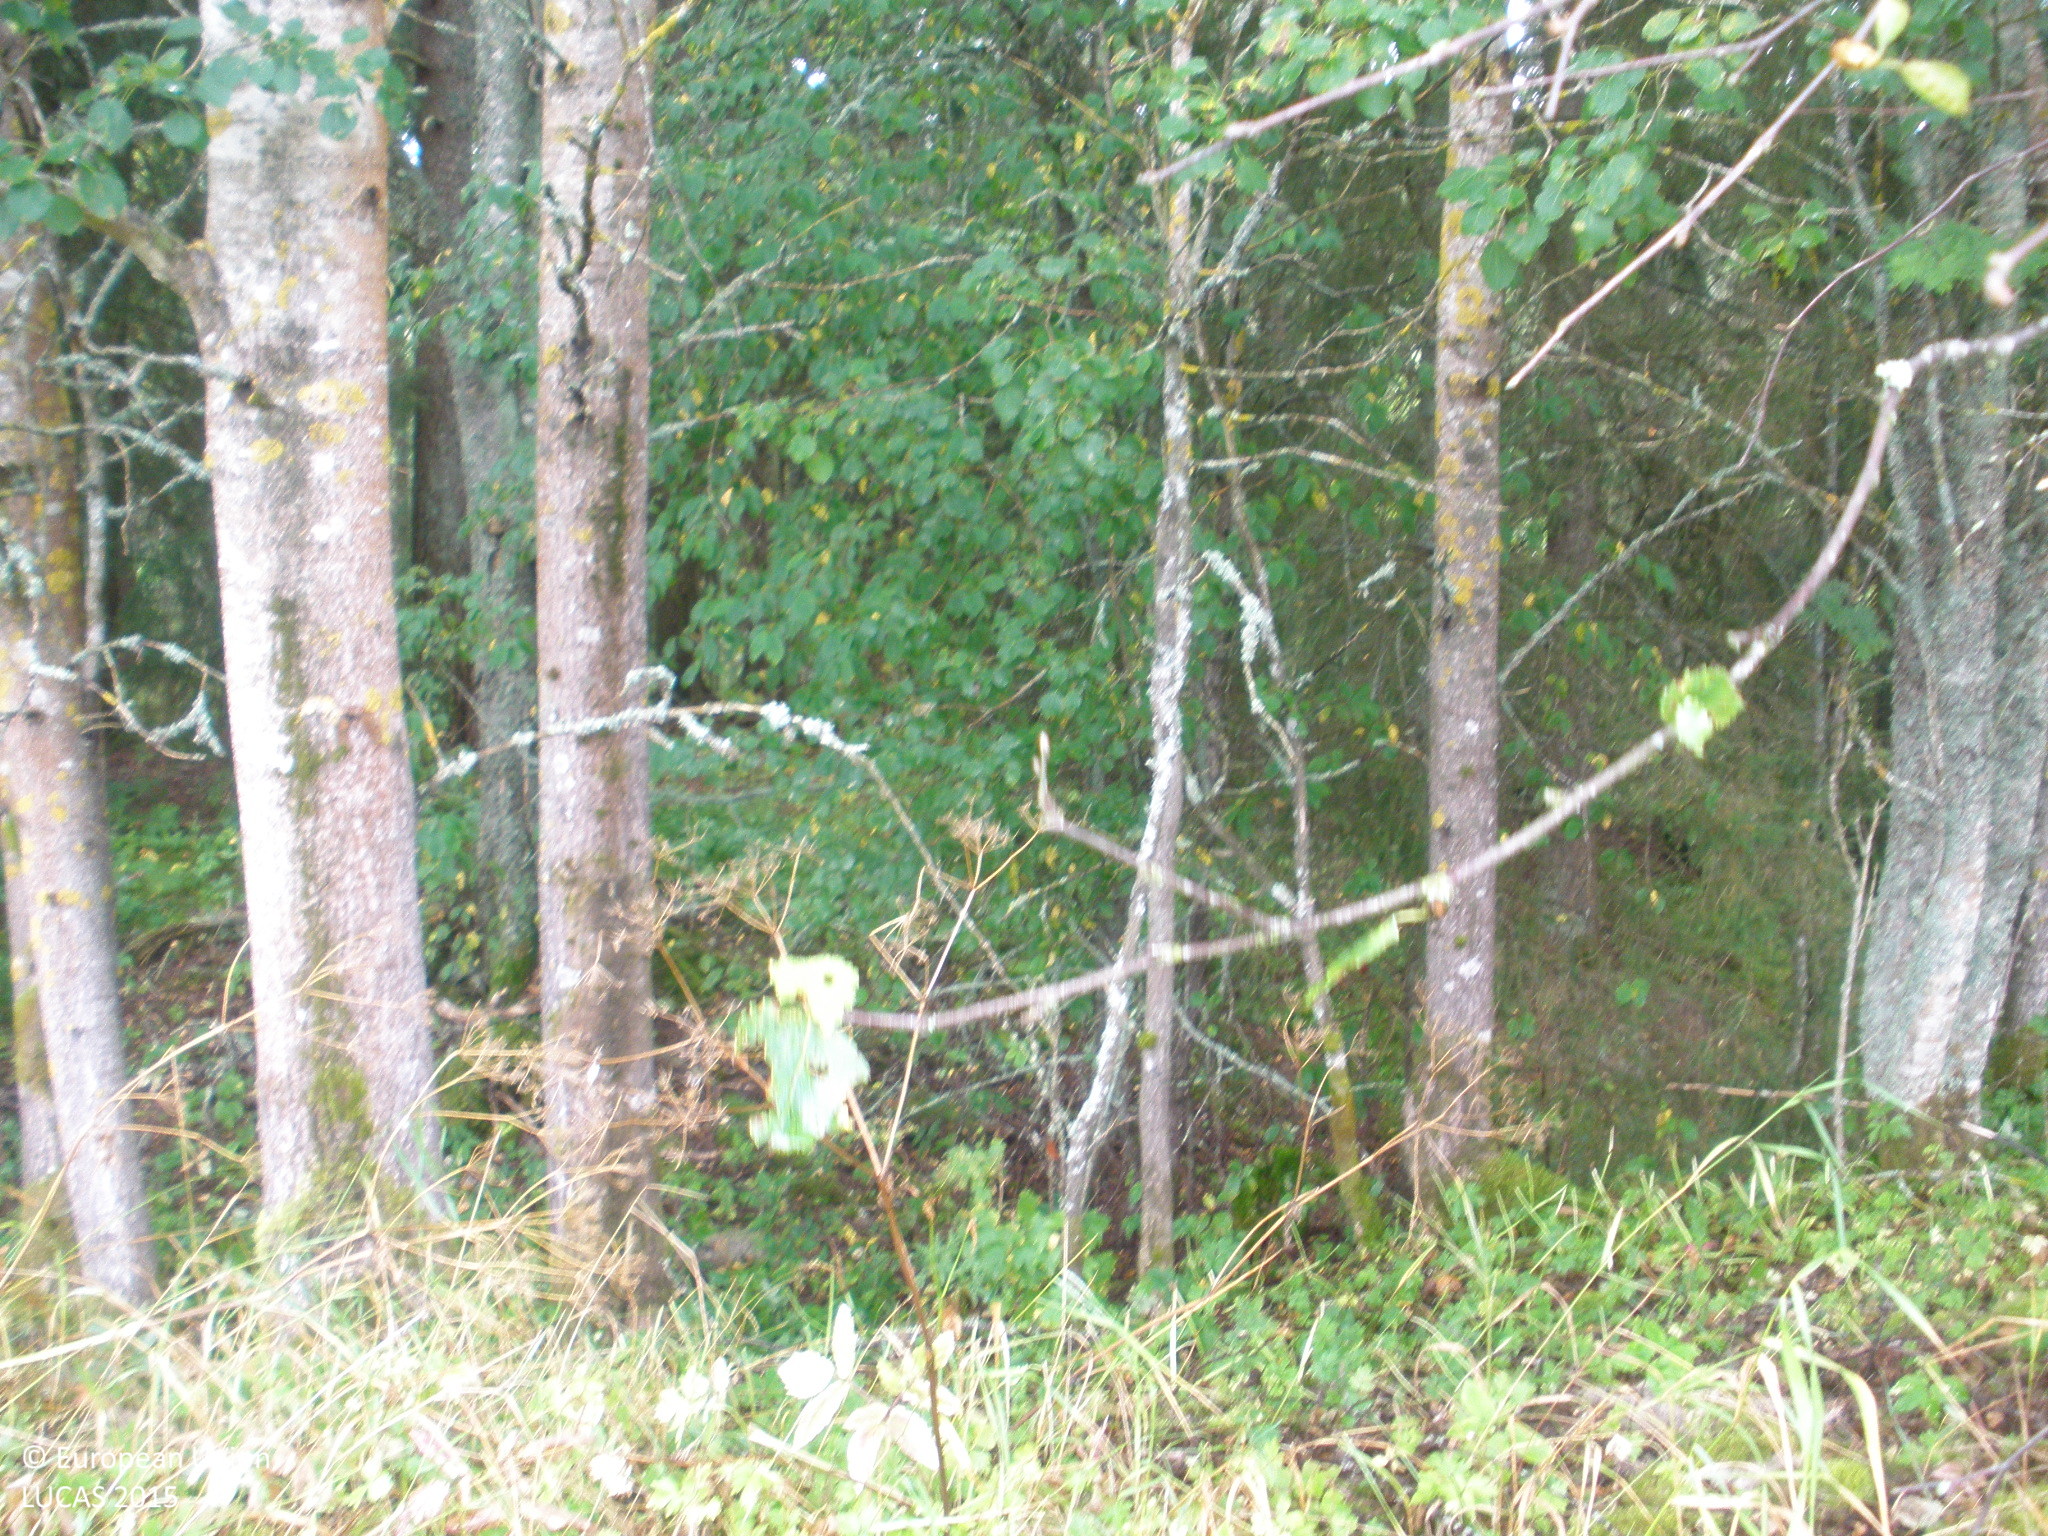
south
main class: Cropland
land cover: Oats
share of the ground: > 75 %
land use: Agriculture (excluding fallow land and kitchen gardens)
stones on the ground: < 10 %
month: August
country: FI
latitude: 60.4868
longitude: 23.4246
